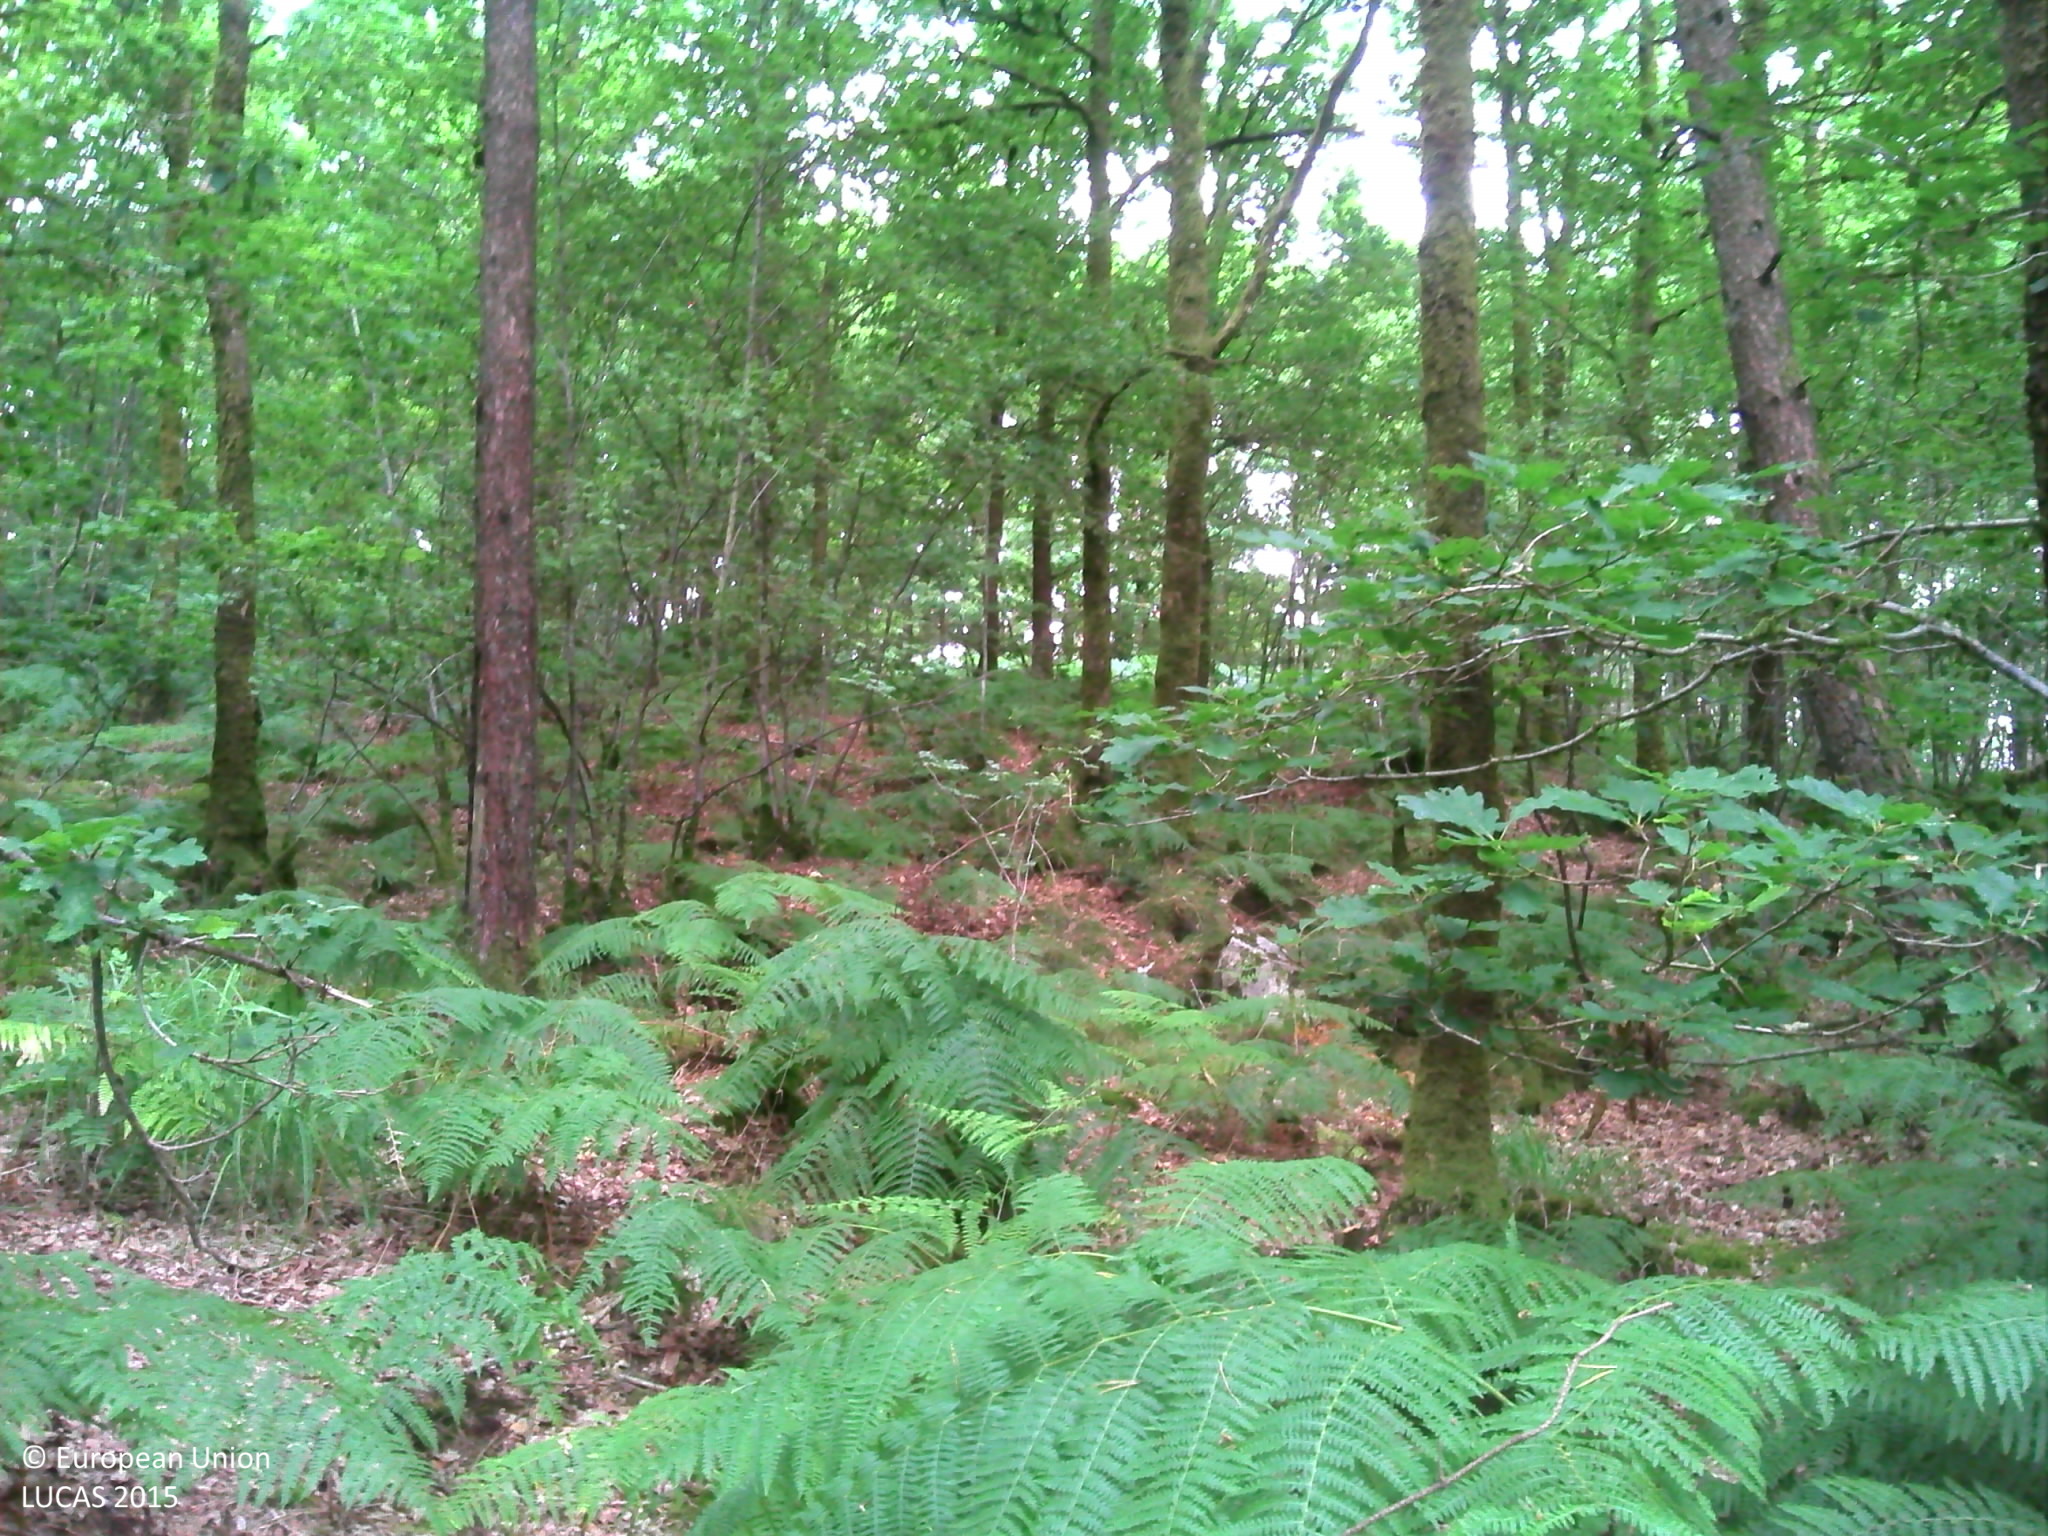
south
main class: Woodland
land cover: Pine dominated mixed woodland
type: acidophilous oak and oak-birch forest
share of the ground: > 75 %
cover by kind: broadleaved forest trees 50 %, coniferous forest trees 30 %, herbaceous plants 20 %
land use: Forestry
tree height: > 5 m
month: July
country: FR
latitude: 48.4473
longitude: -0.1026
